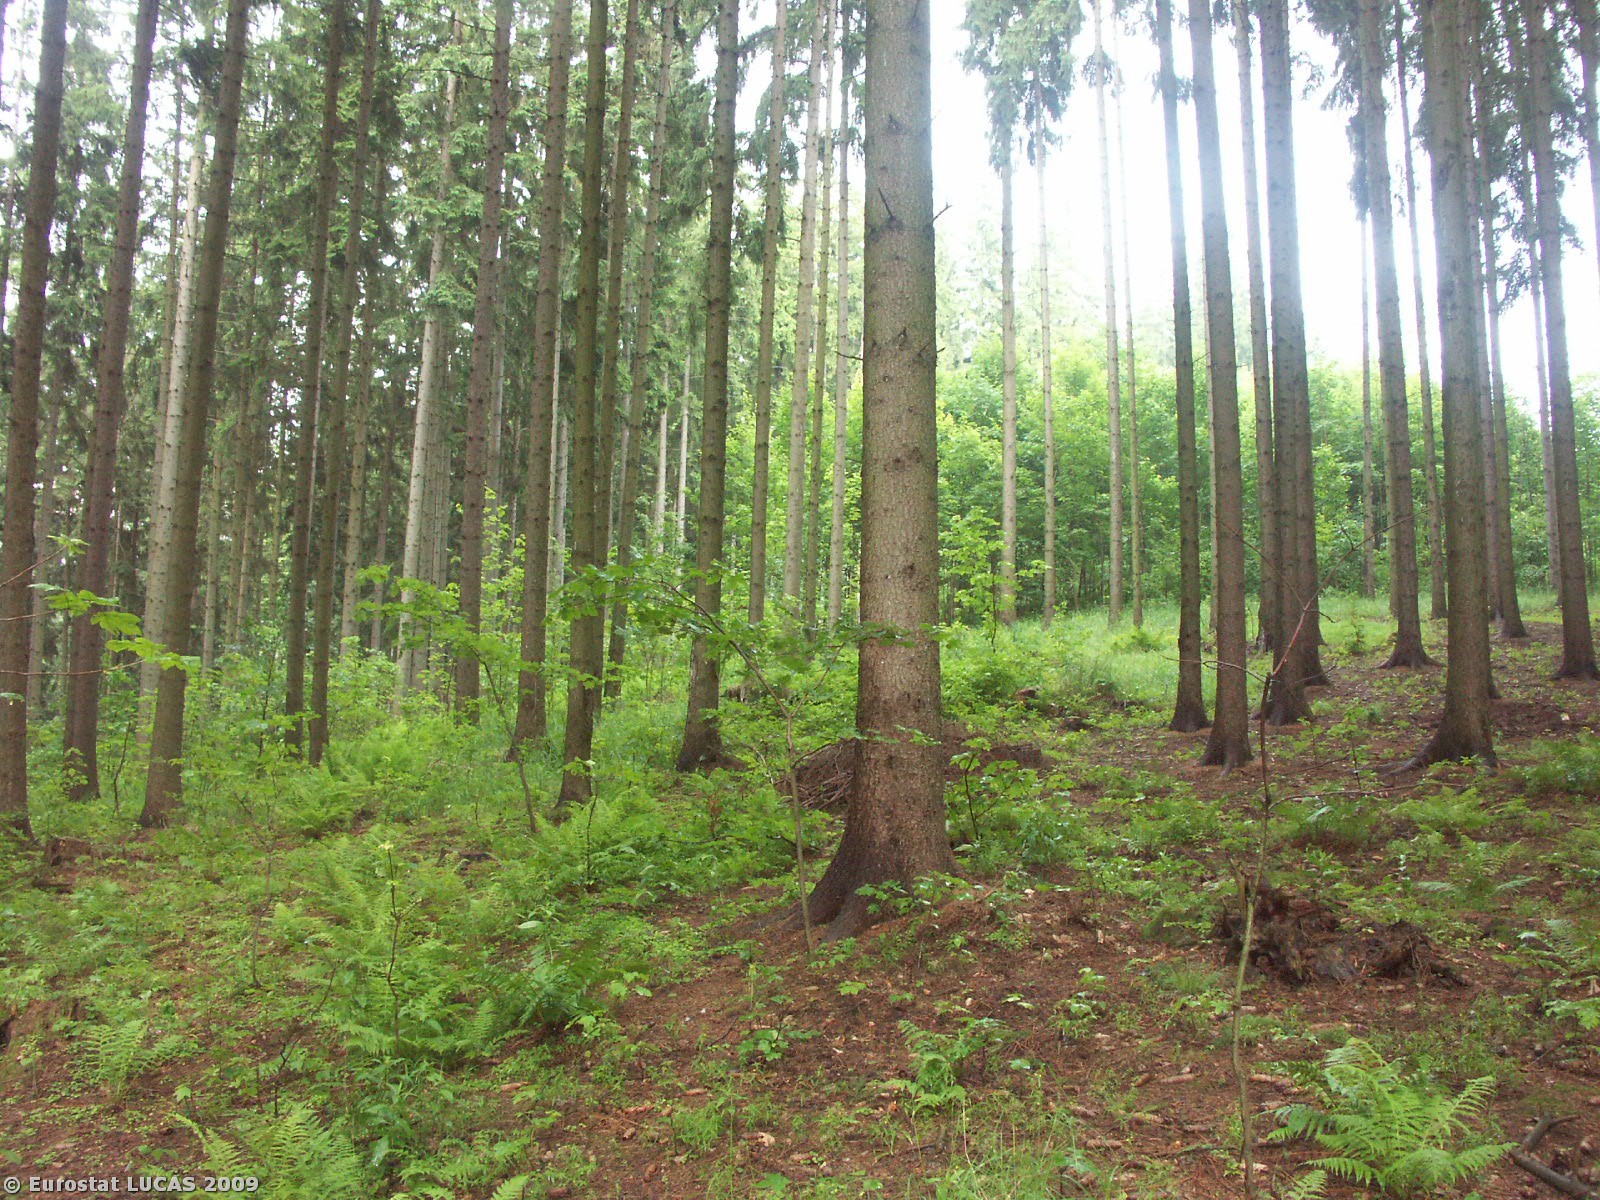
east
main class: Woodland
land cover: Coniferous woodland
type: hemiboreal forest and nemoral coniferous forest and mixed broadleaved-coniferous forest
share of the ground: > 75 %
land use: Forestry
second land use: Nature reserves
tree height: > 5 m
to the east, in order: Coniferous woodland; Broadleaved woodland; Coniferous woodland
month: June
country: CZ
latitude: 50.0161
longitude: 17.1138
